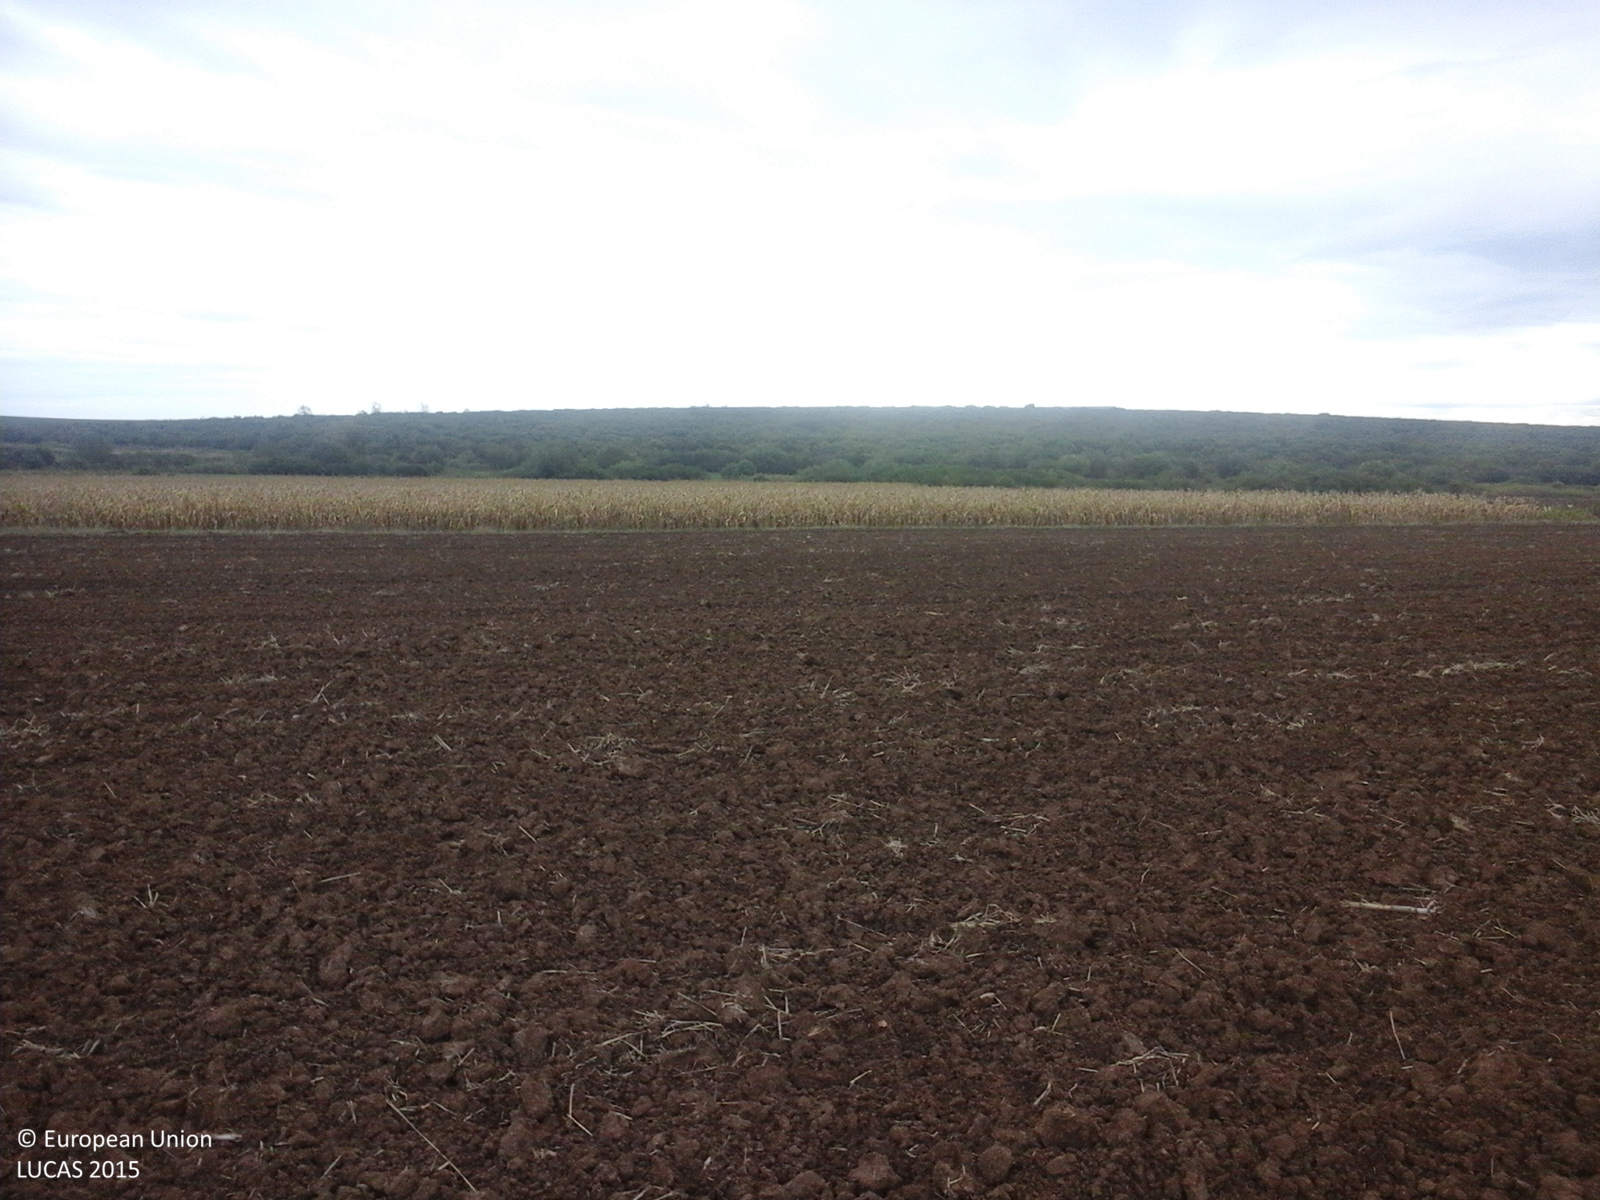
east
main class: Cropland
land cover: Common wheat
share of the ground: < 10 %
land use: Agriculture (excluding fallow land and kitchen gardens)
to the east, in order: Common wheat; Grass margins; Tracks; Grass margins; Maize; Spontaneously vegetated surfaces; Common wheat
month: September
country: RO
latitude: 47.4766
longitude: 22.4631
